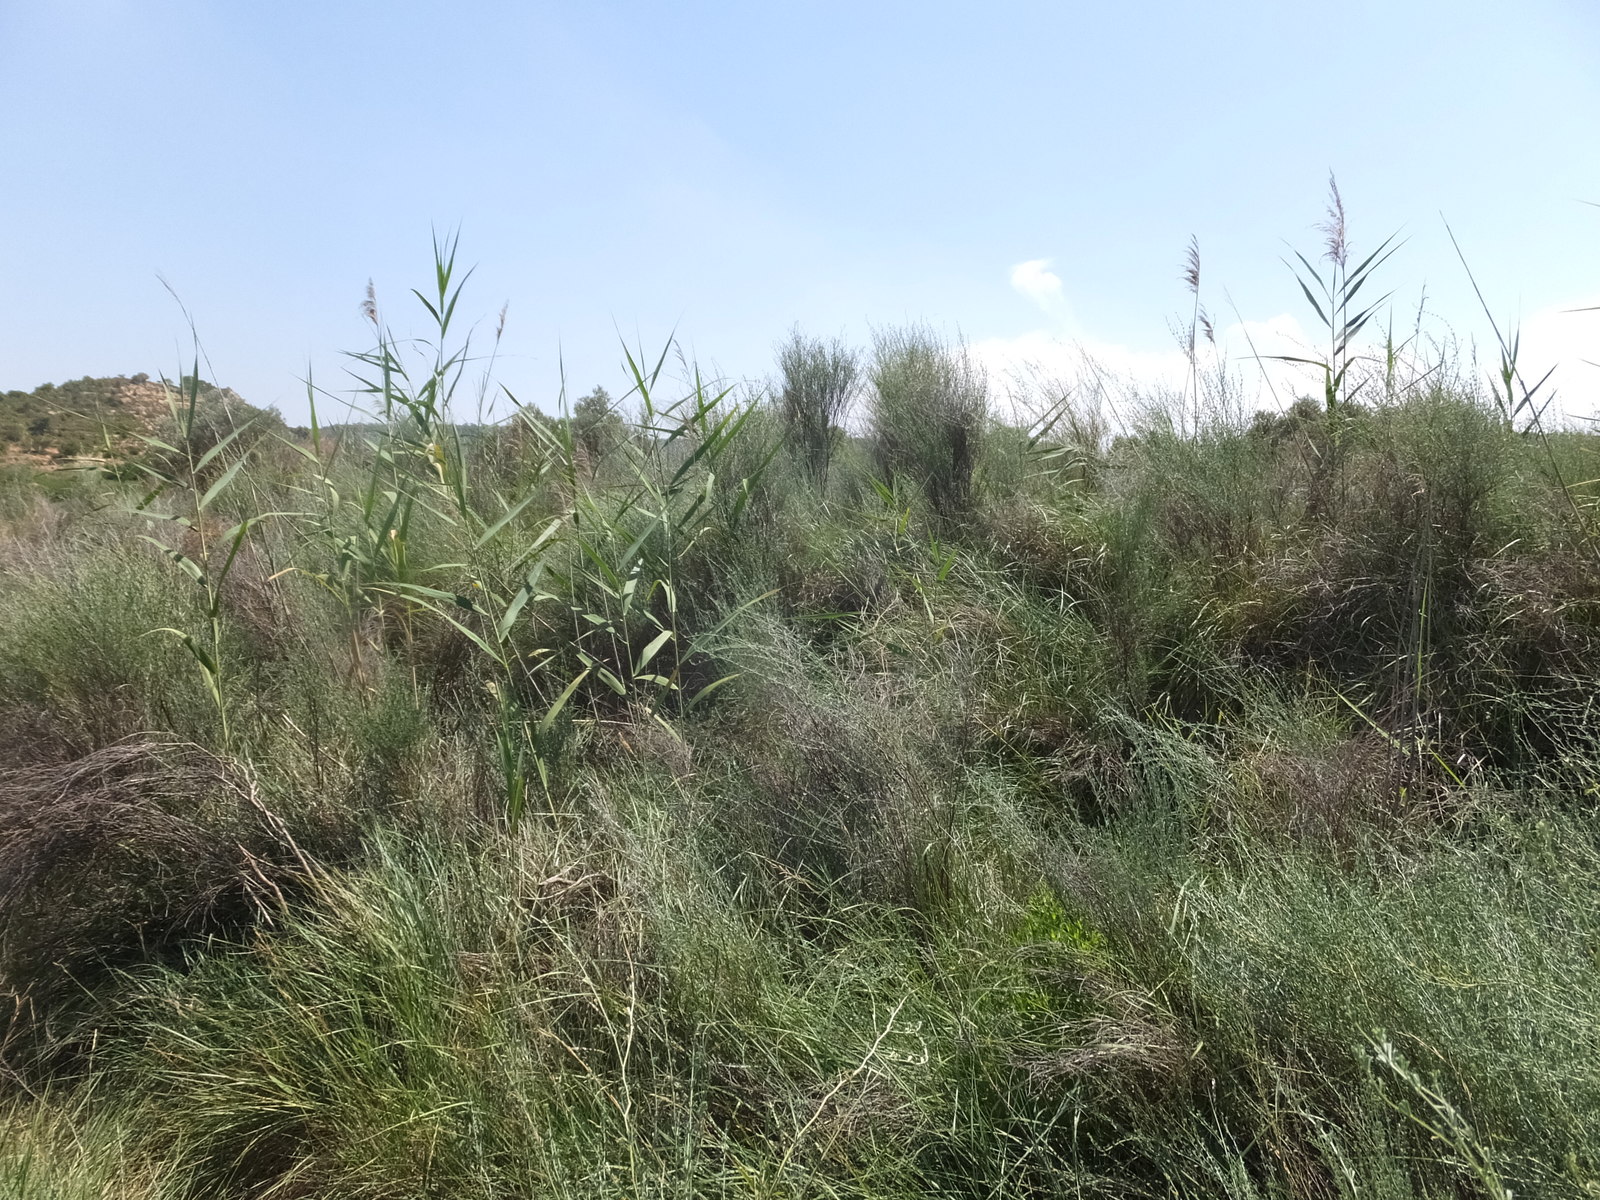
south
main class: Shrubland
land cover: Shrubland without tree cover
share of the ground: > 75 %
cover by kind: shrubs 75 %, herbaceous plants 25 %
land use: Semi-natural and natural areas not in use
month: July
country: ES
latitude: 41.2314
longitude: 0.1940
